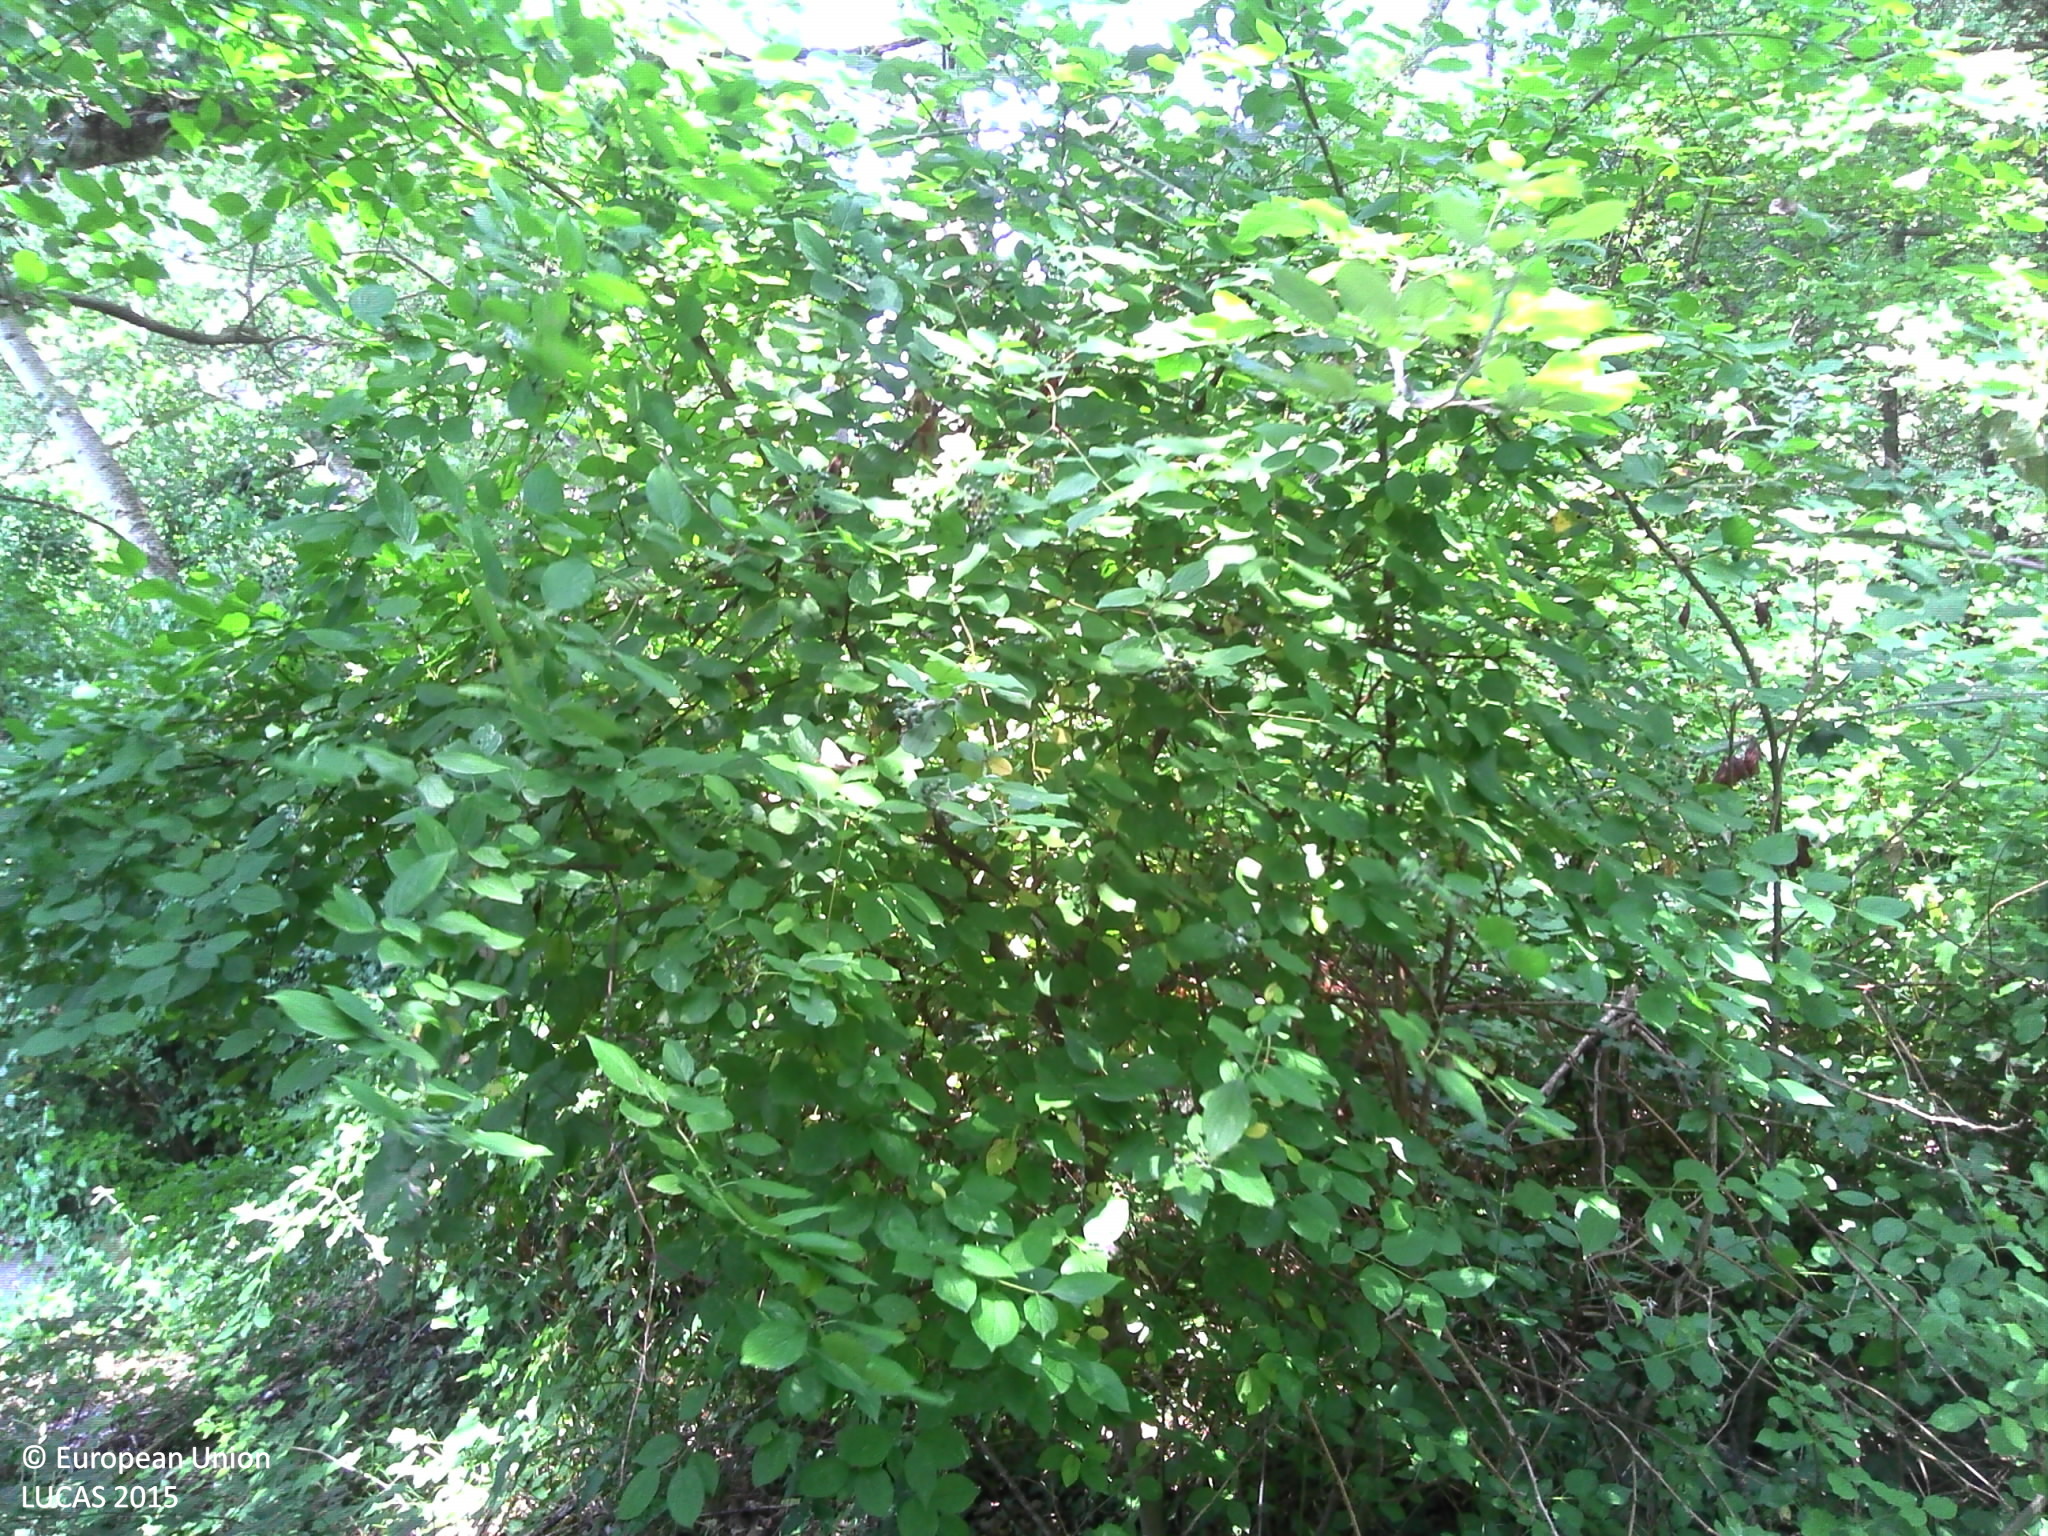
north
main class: Woodland
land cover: Broadleaved woodland
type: floodplain forest
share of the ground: 50 - 75 %
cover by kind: broadleaved forest trees 60 %, shrubs 20 %, coniferous forest trees 10 %, herbaceous plants 10 %
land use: Semi-natural and natural areas not in use
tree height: > 5 m
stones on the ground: < 10 %
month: July
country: FR
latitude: 44.2518
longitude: 4.7100
